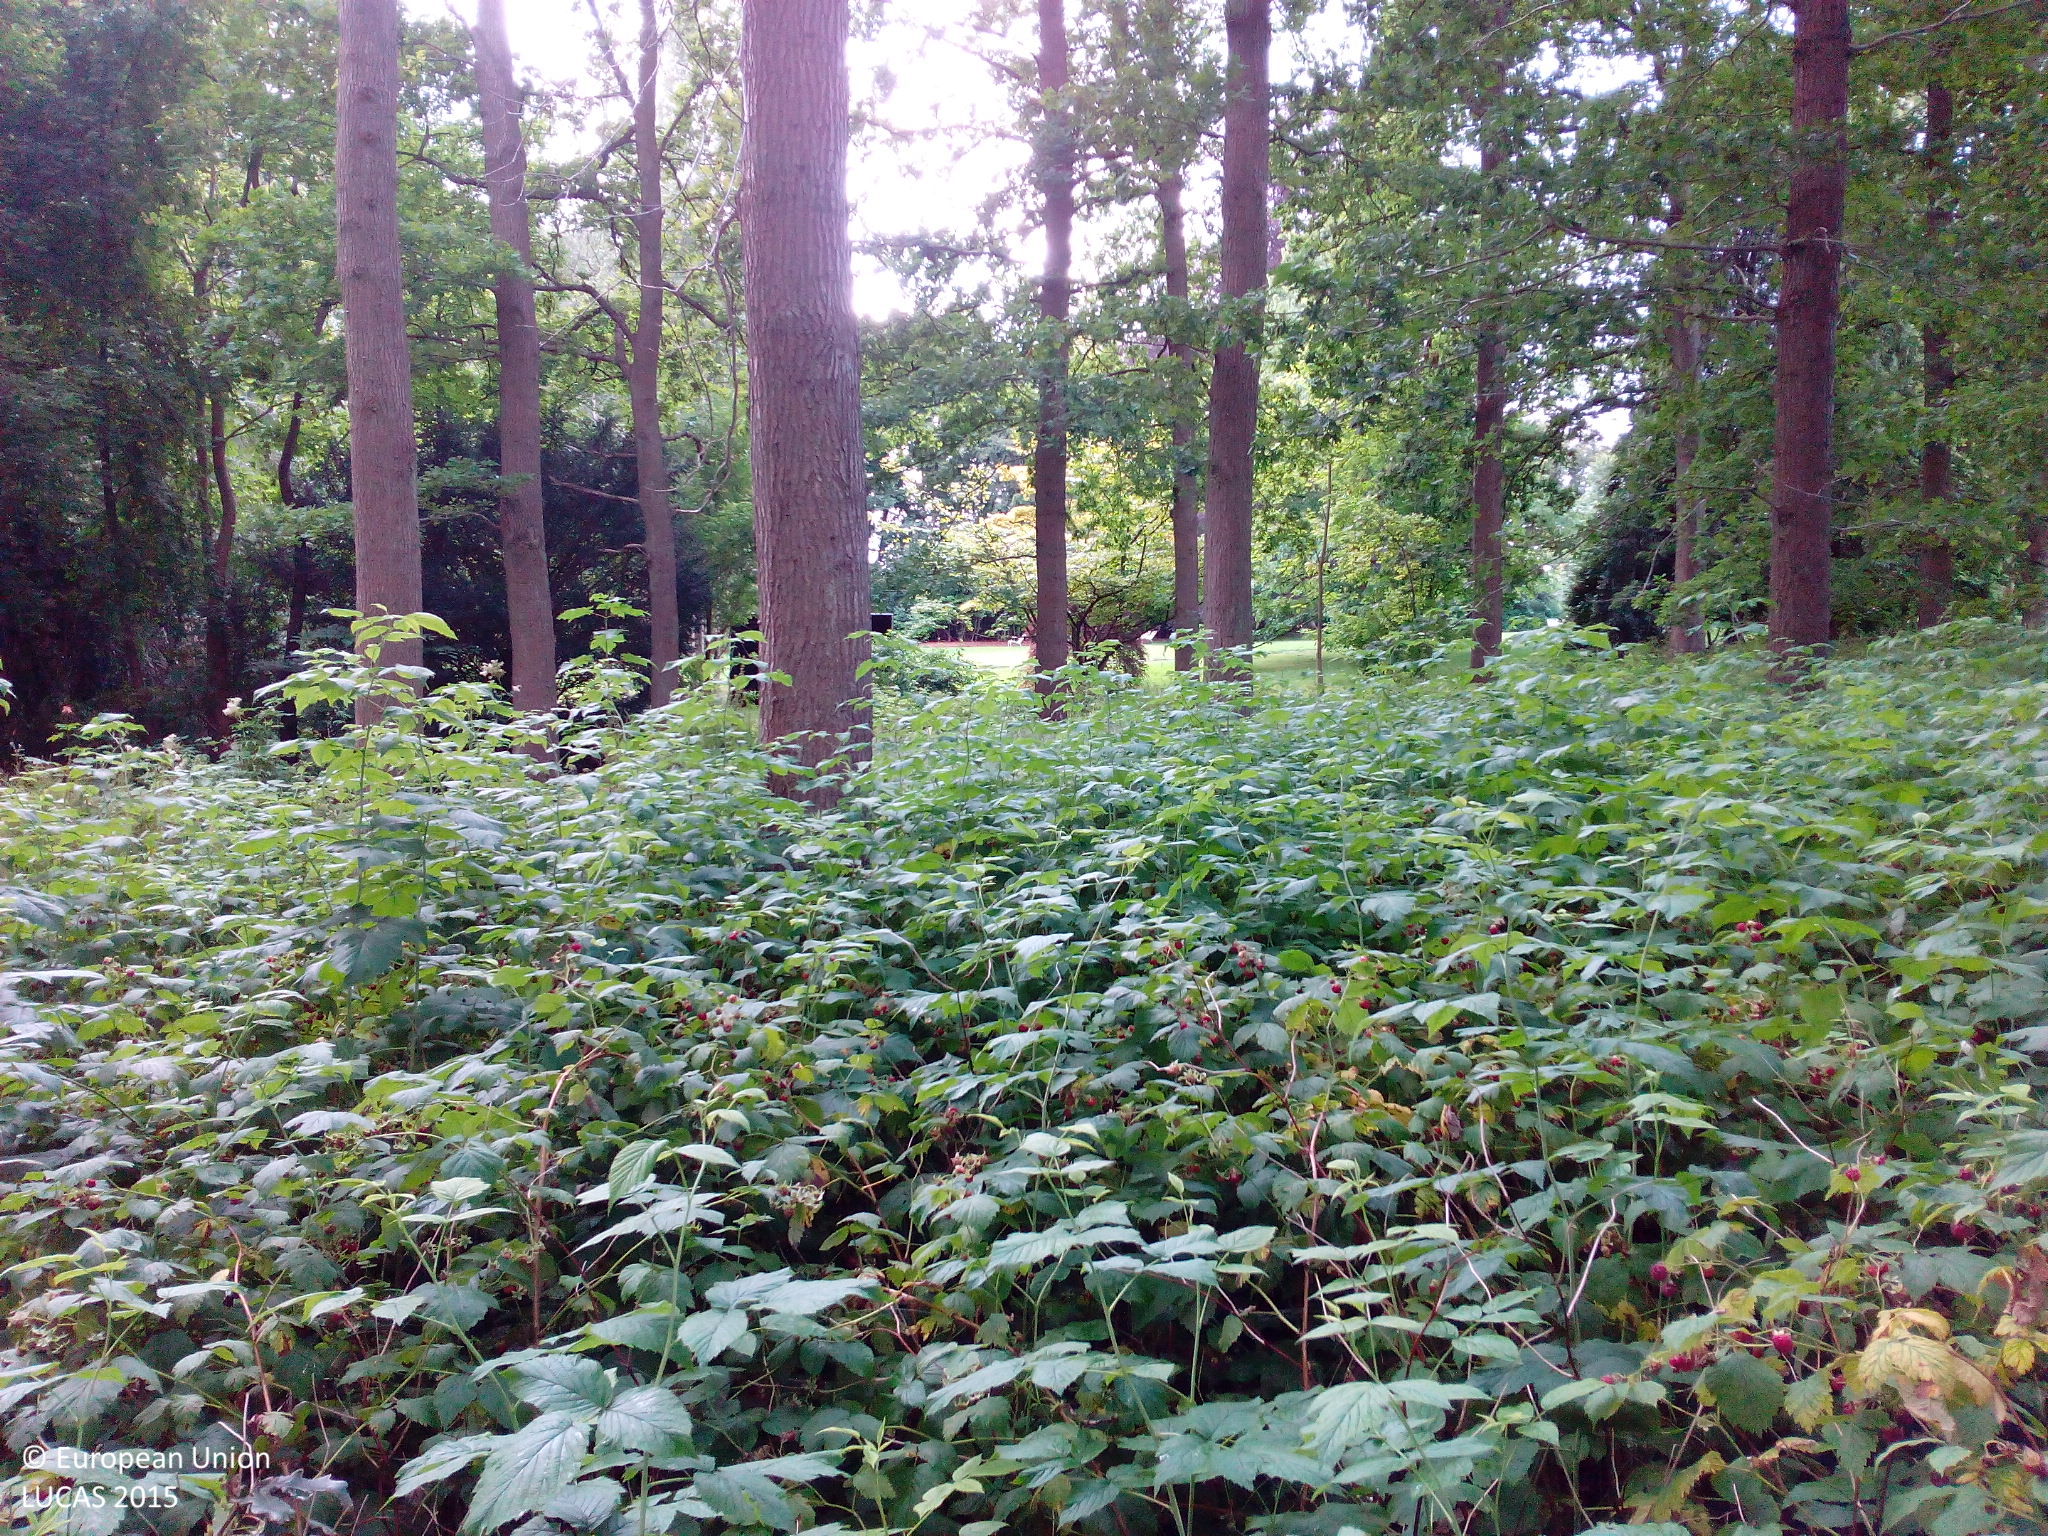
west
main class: Woodland
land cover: Broadleaved woodland
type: acidophilous oak and oak-birch forest
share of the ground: > 75 %
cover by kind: broadleaved forest trees 80 %, herbaceous plants 20 %
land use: Amenities, museums, leisure
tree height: > 5 m
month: July
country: DK
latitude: 55.7665
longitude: 12.5640
